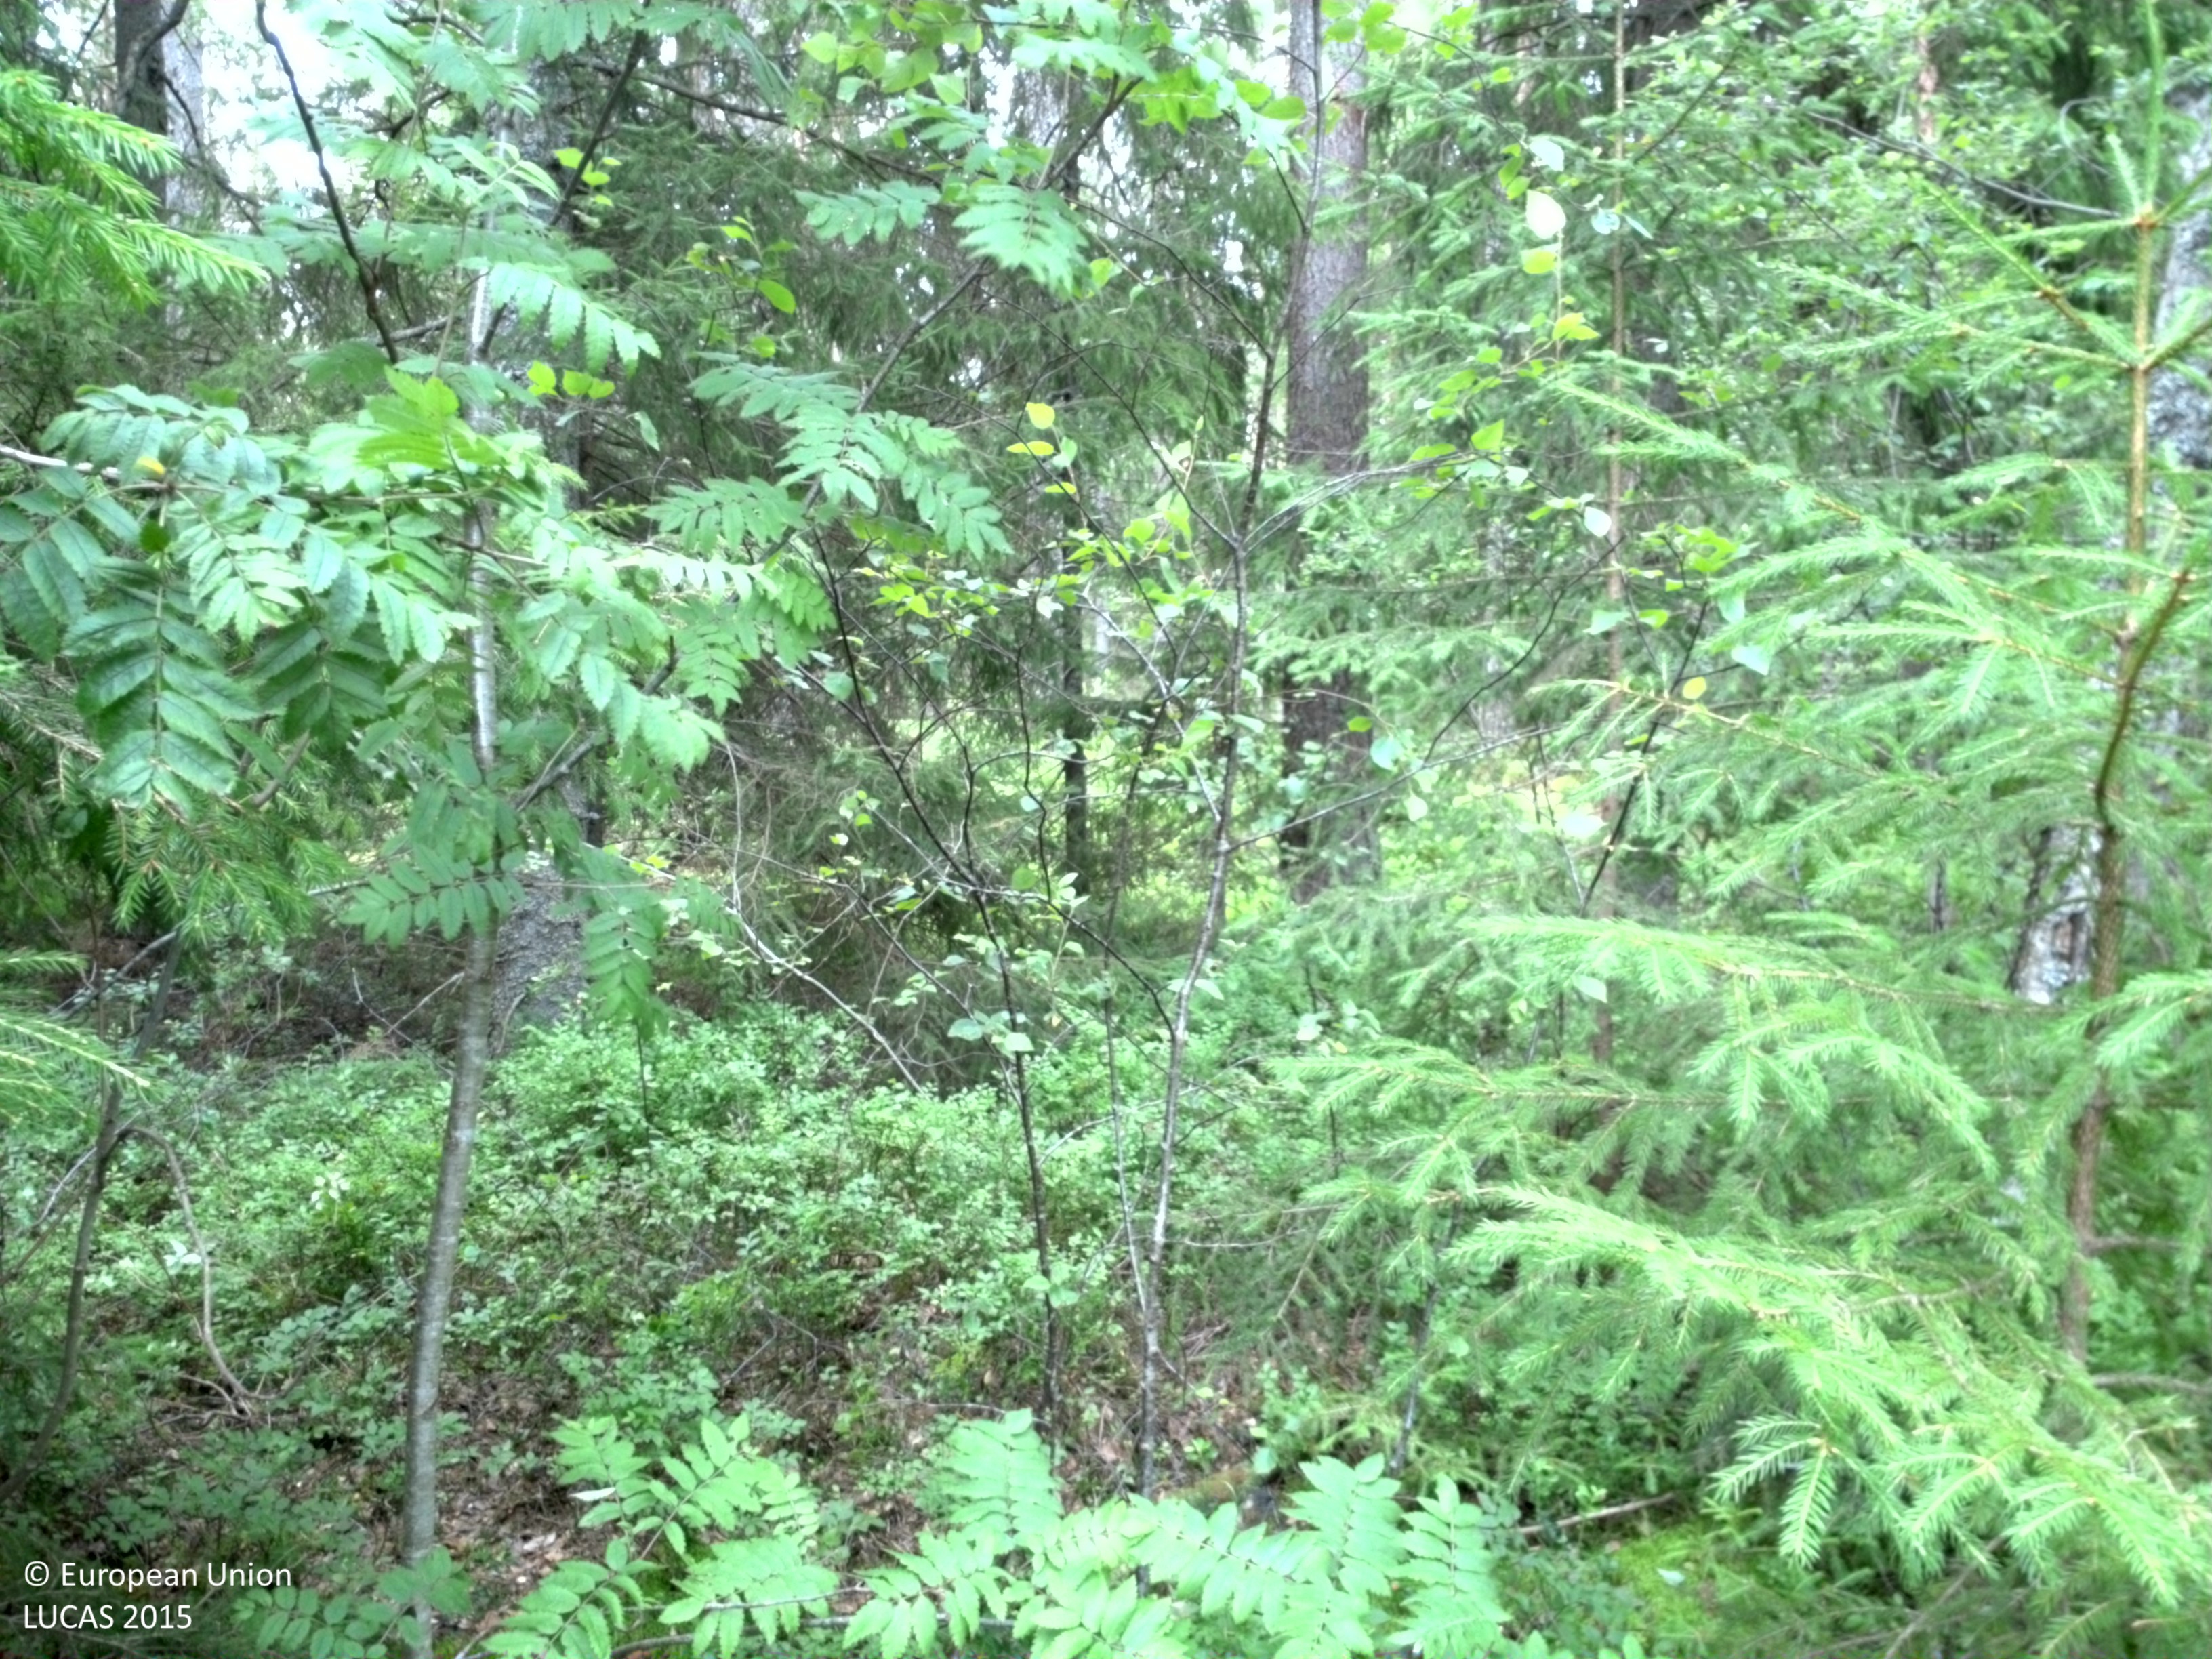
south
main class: Woodland
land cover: Spruce dominated mixed woodland
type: boreal forest
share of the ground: 25 - 50 %
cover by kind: coniferous forest trees 30 %, herbaceous plants 30 %, broadleaved forest trees 15 %, lichens and mosses 15 %, shrubs 10 %
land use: Forestry
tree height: > 5 m
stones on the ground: 10 - 25 %
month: July
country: SE
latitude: 58.9089
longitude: 14.8017
